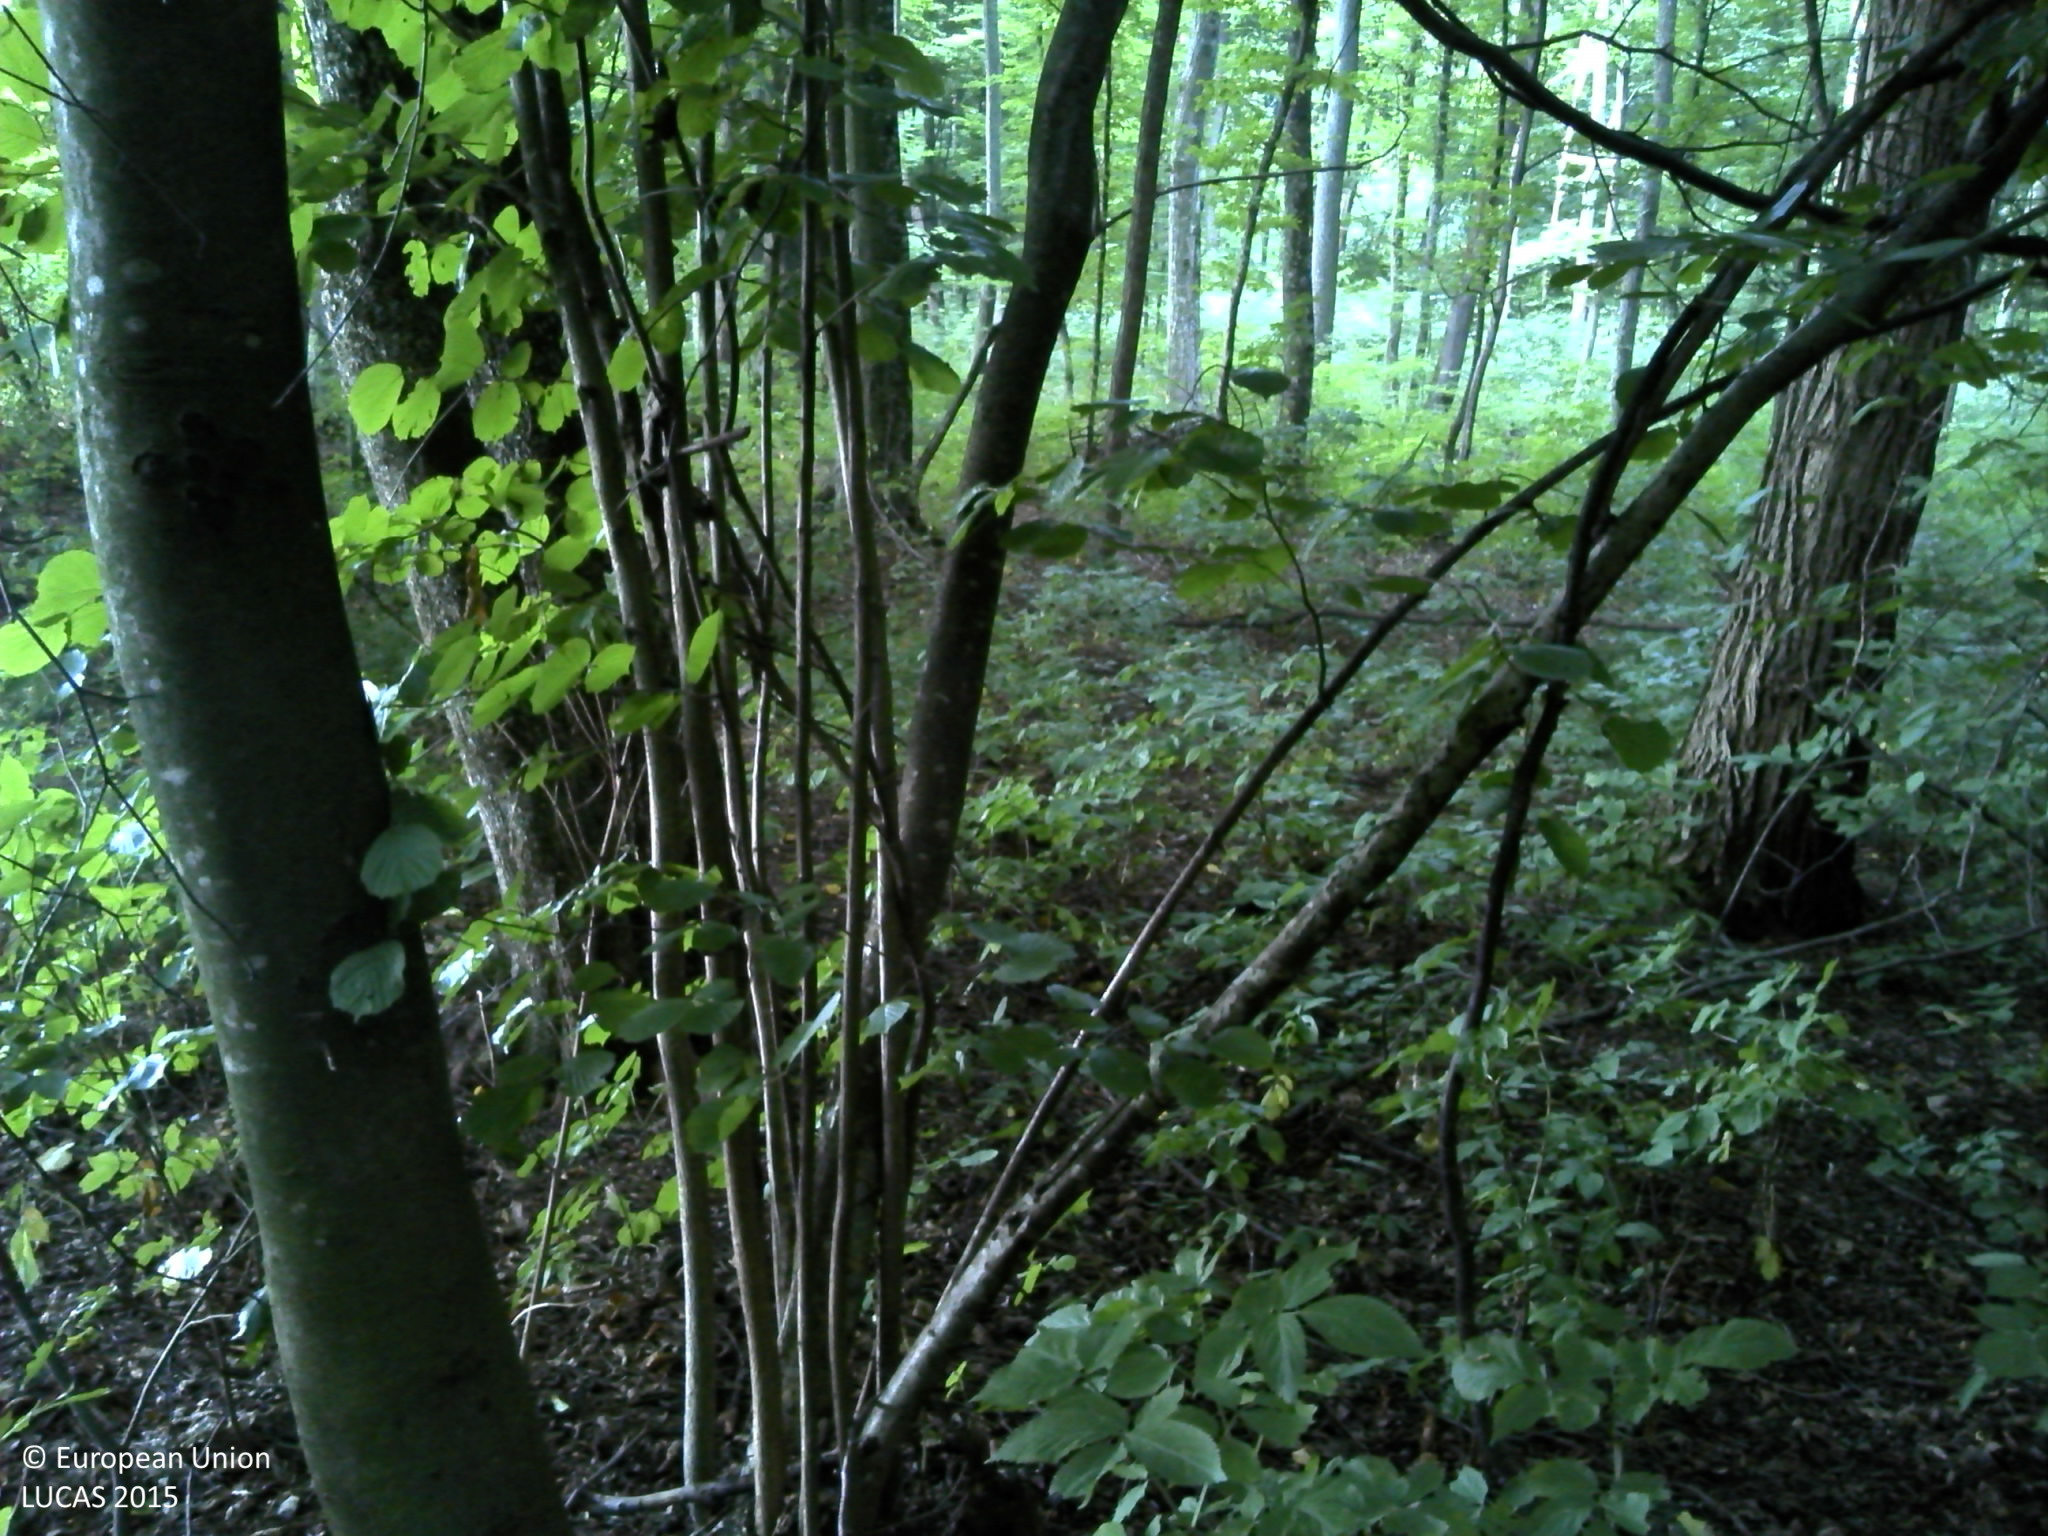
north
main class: Woodland
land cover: Broadleaved woodland
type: beech forest
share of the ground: > 75 %
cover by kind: broadleaved forest trees 100 %
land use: Forestry
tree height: > 5 m
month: August
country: HR
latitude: 45.5453
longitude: 17.2371
